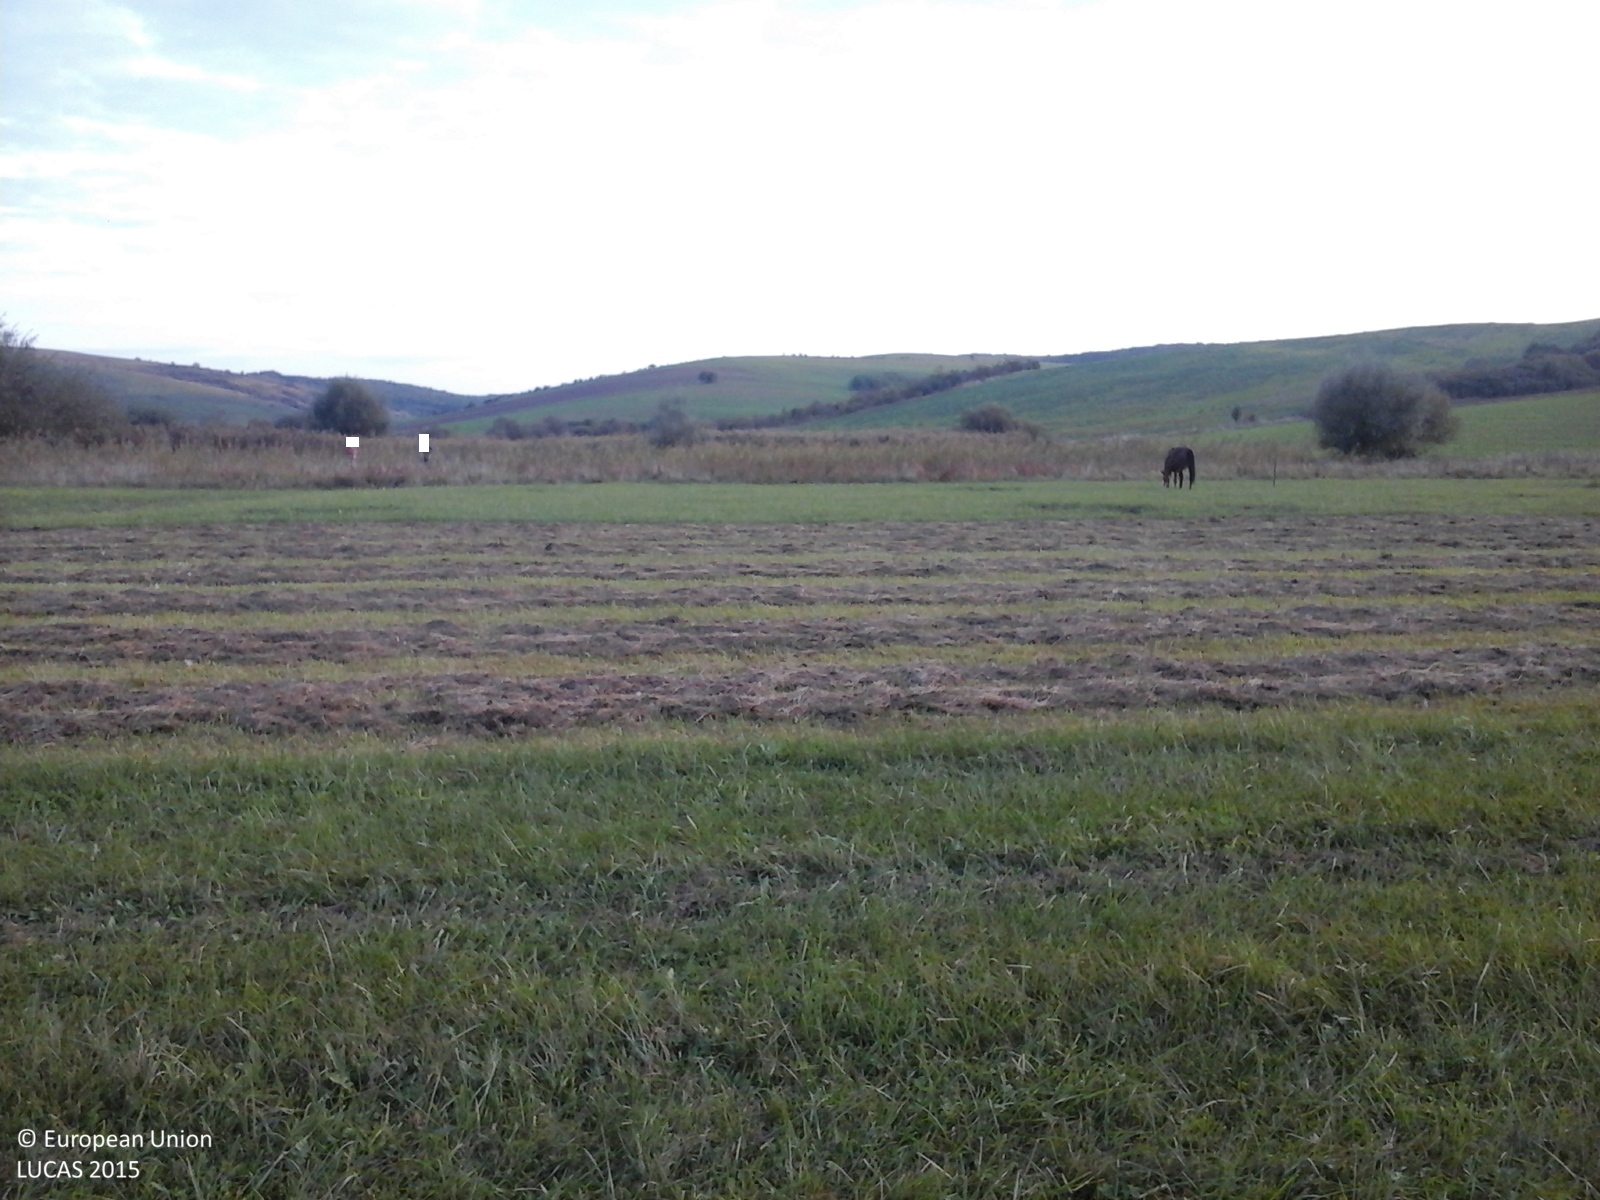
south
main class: Grassland
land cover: Grassland without tree/shrub cover
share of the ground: > 75 %
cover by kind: herbaceous plants 100 %
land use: Agriculture (excluding fallow land and kitchen gardens)
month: October
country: RO
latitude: 46.2845
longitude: 24.2667
